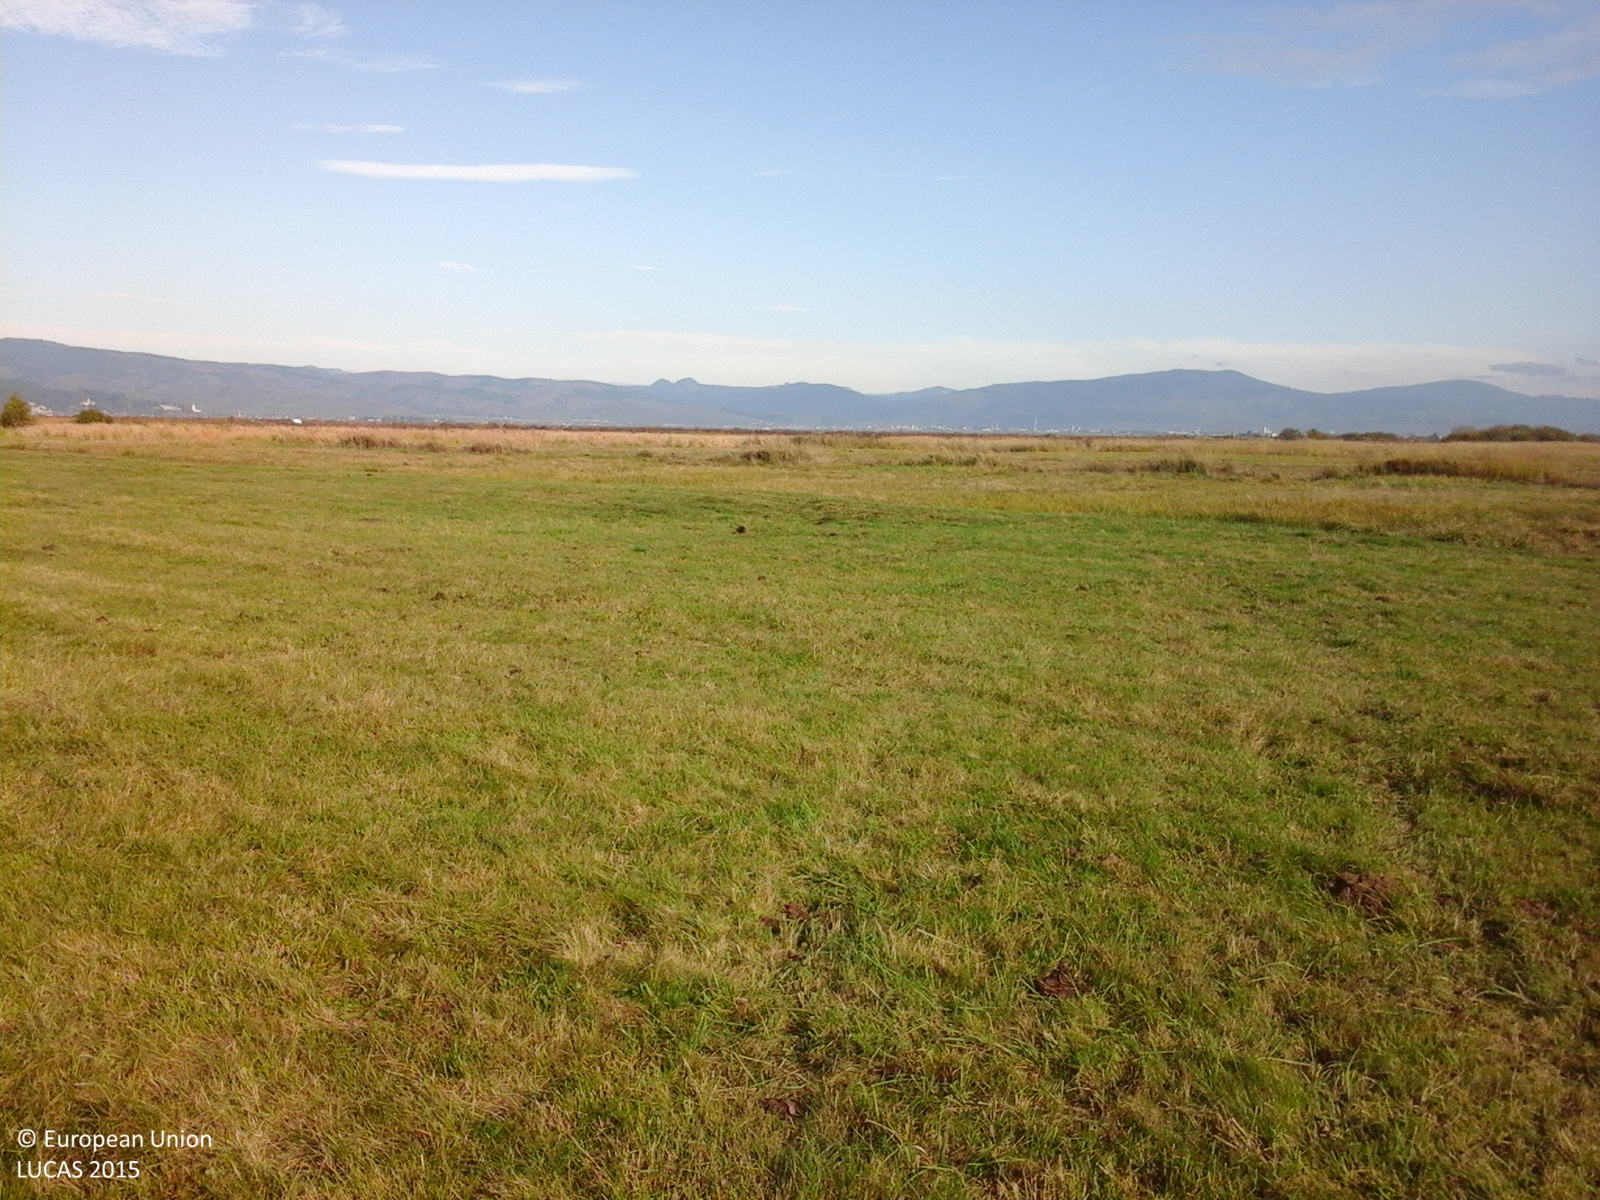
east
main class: Grassland
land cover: Grassland without tree/shrub cover
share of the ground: > 75 %
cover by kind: herbaceous plants 100 %
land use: Agriculture (excluding fallow land and kitchen gardens)
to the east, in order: Grassland without tree/shrub cover; Spontaneously vegetated surfaces; Grassland without tree/shrub cover
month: October
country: RO
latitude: 46.7218
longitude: 25.4564
